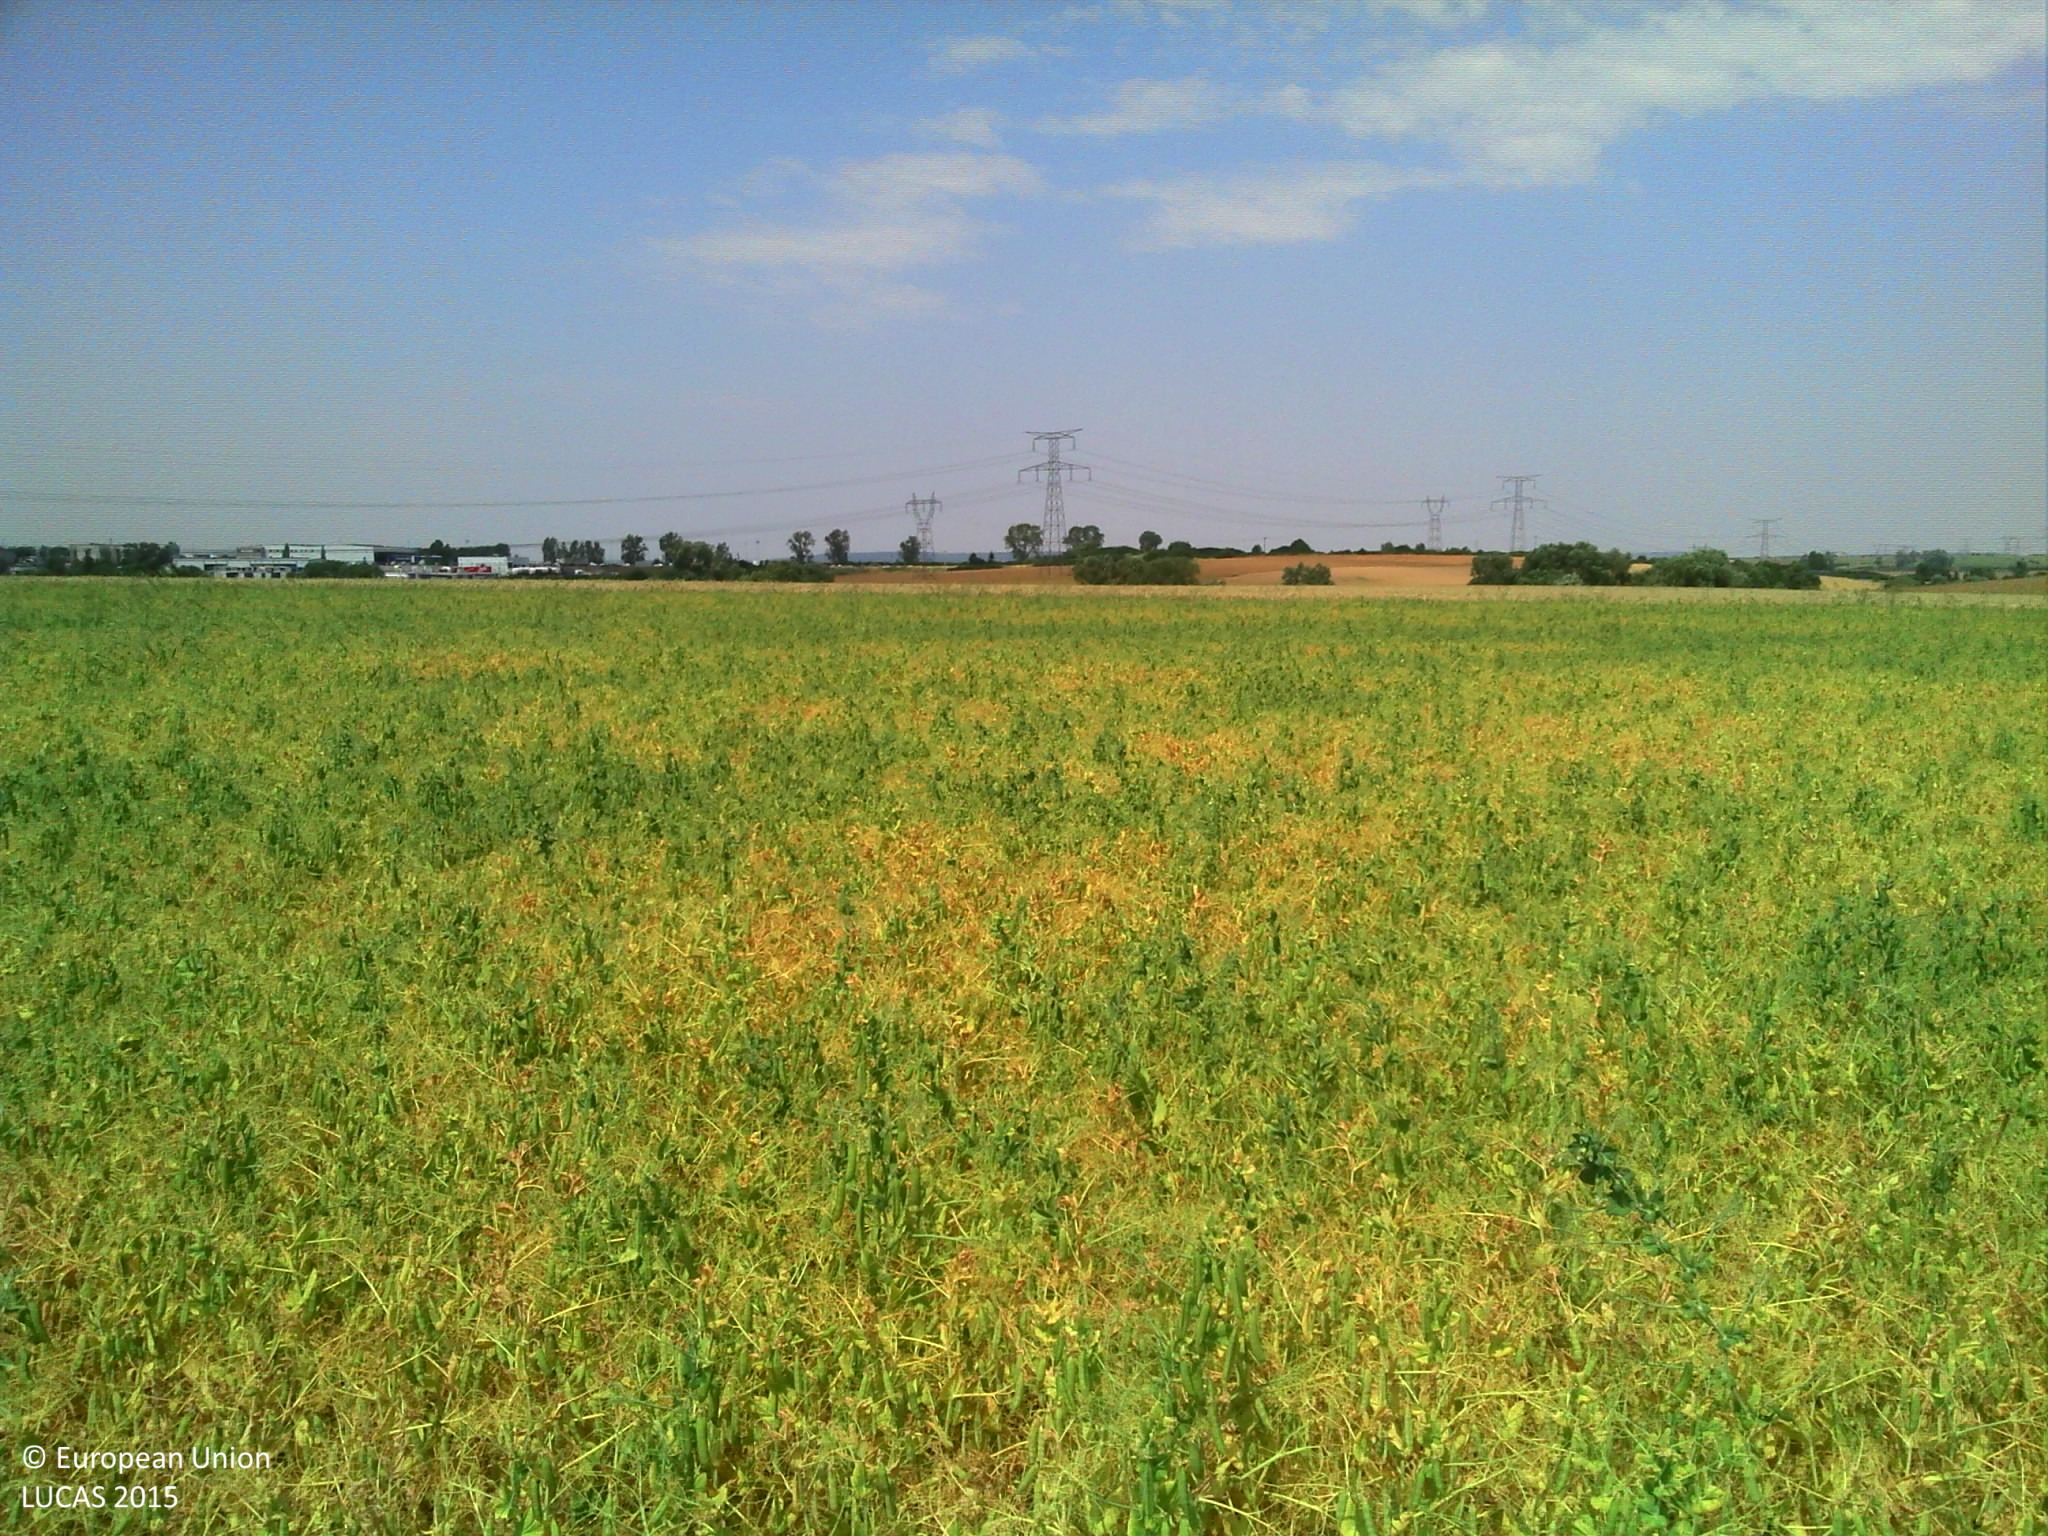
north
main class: Cropland
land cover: Dry pulses
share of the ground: > 75 %
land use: Agriculture (excluding fallow land and kitchen gardens)
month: July
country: FR
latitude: 48.6090
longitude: 6.2161
